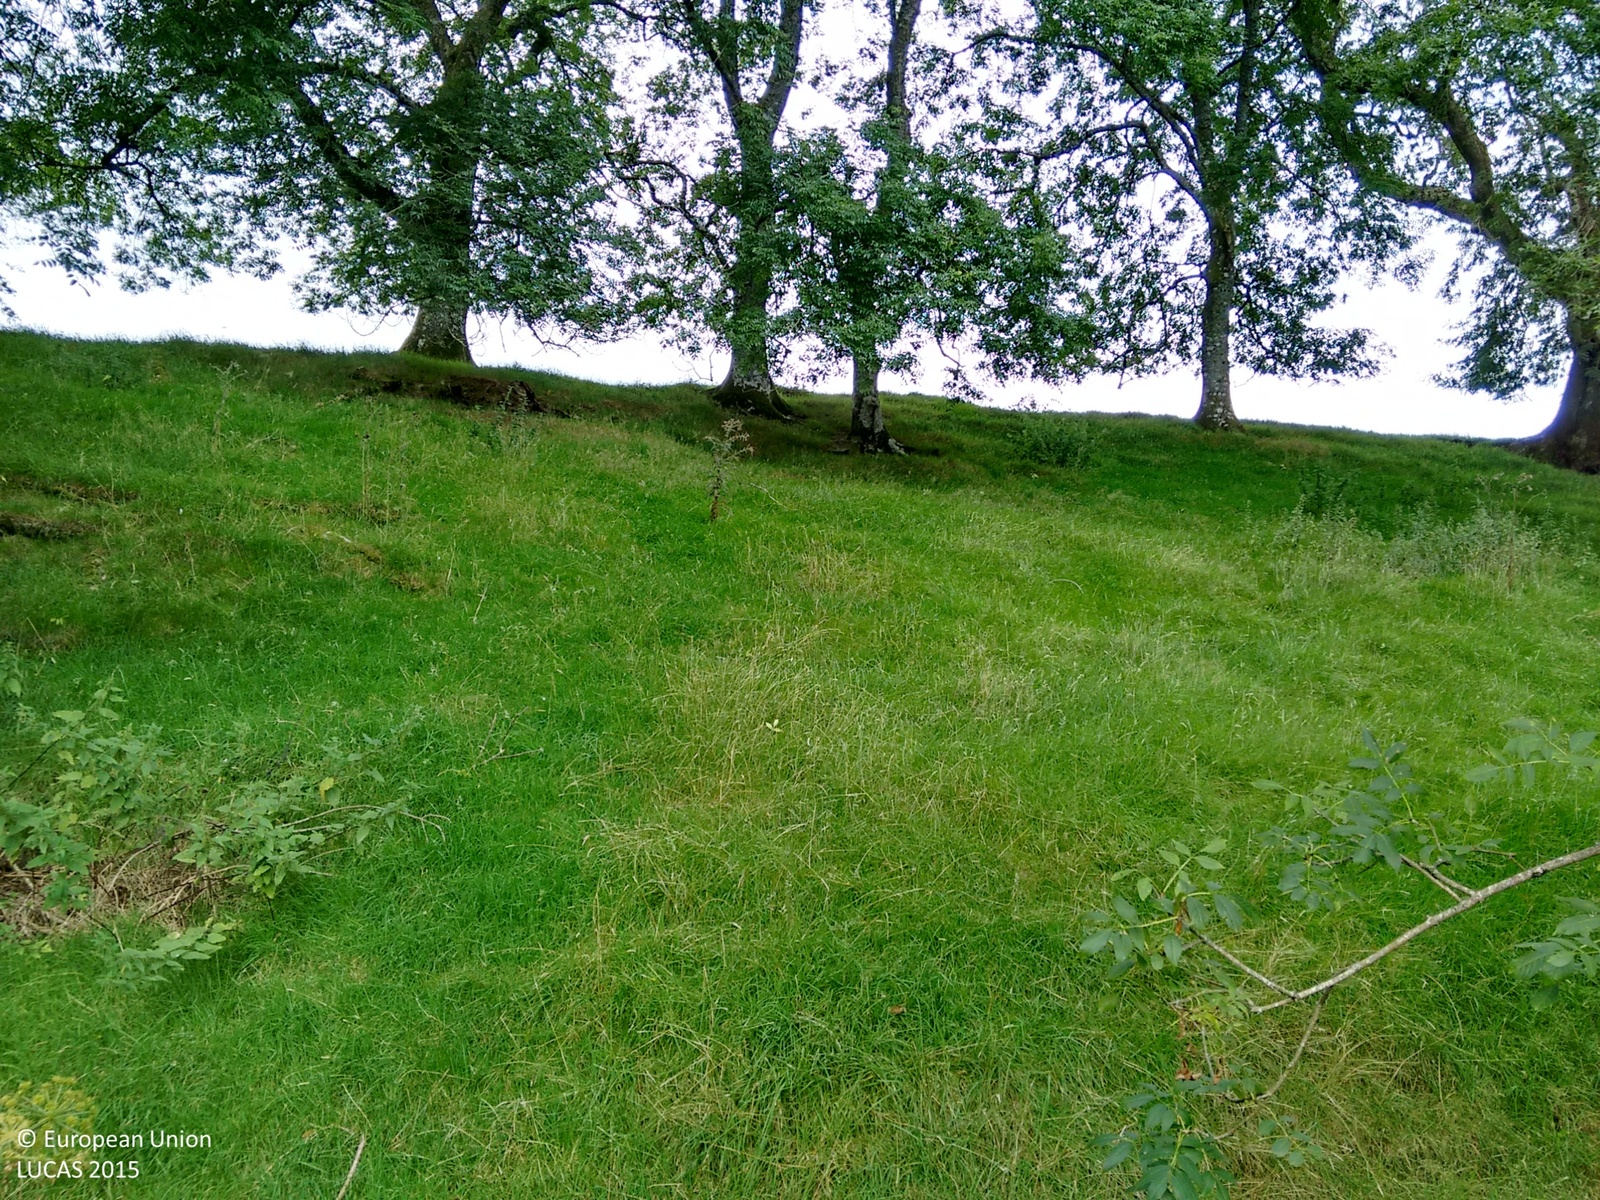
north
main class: Woodland
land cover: Broadleaved woodland
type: mesophytic deciduous forest
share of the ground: > 75 %
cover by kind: broadleaved forest trees 80 %, herbaceous plants 20 %
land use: Agriculture (excluding fallow land and kitchen gardens)
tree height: > 5 m
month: September
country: GB
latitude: 52.1823
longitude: -3.5257
